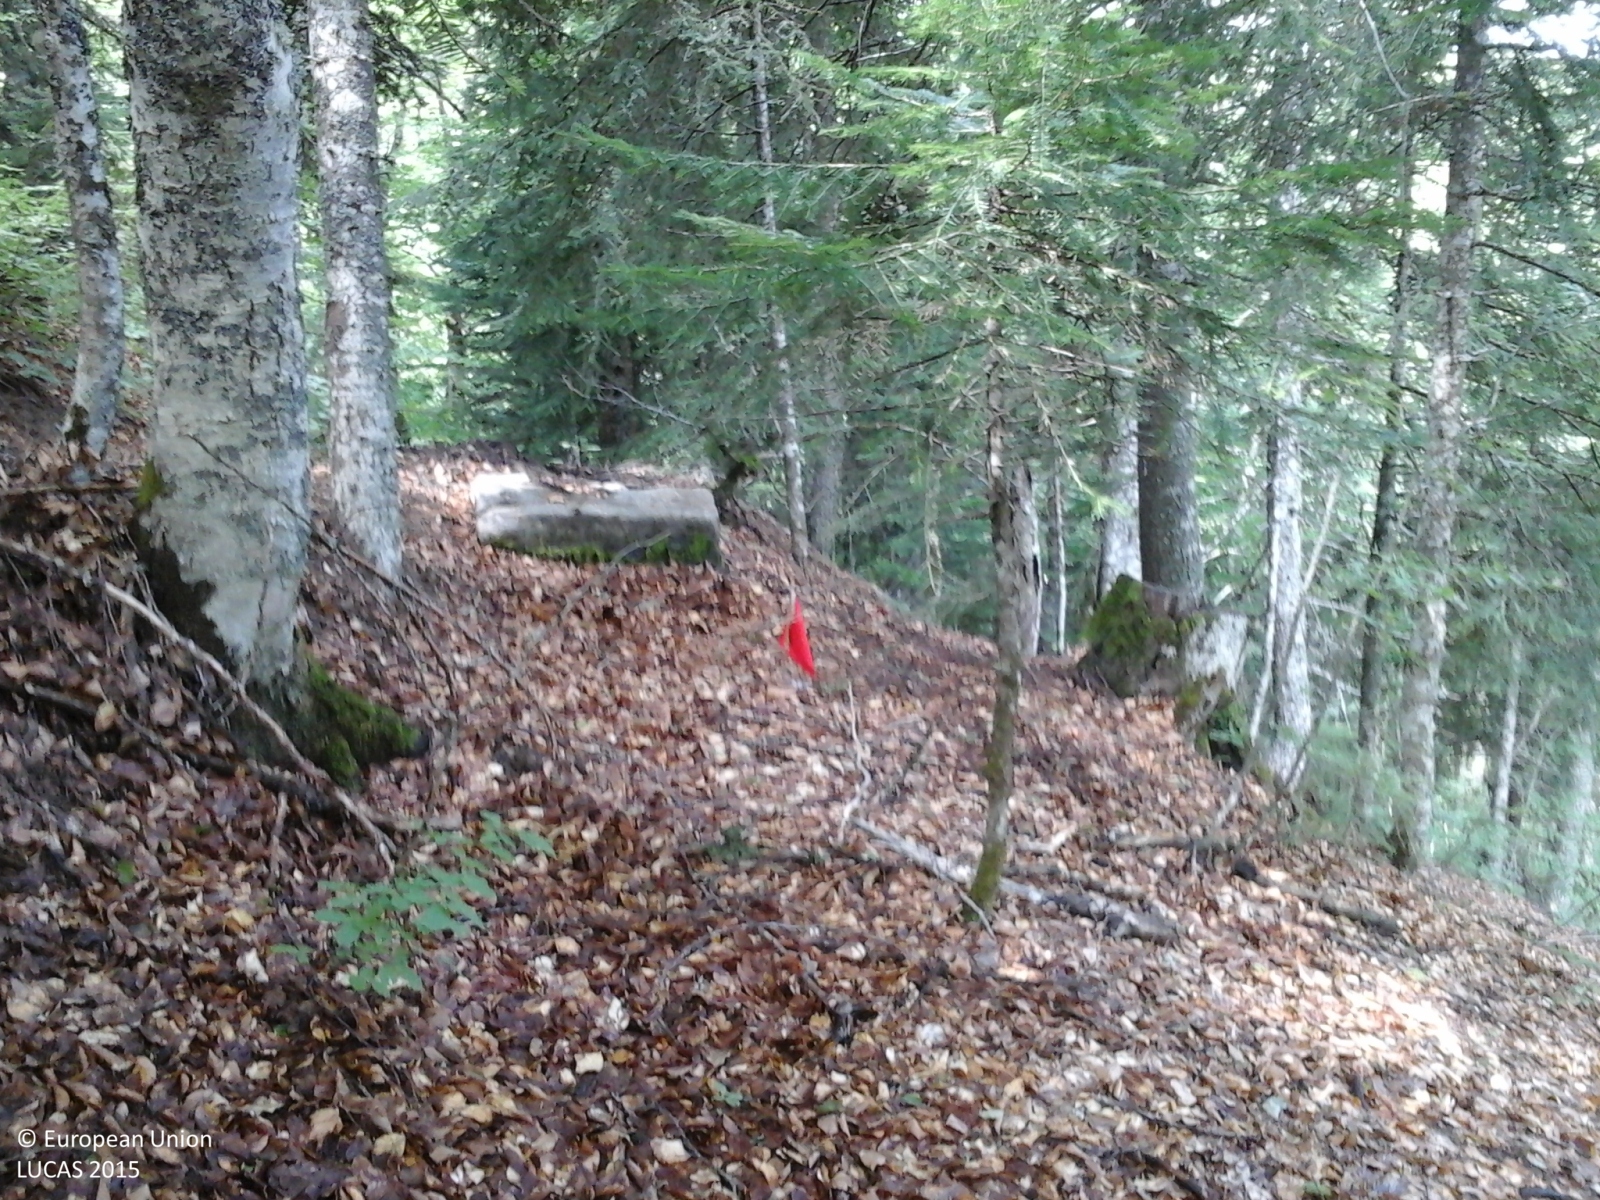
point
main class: Woodland
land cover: Spruce dominated coniferous woodland
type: coniferous forest of the mediterranean region
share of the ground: 50 - 75 %
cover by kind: coniferous forest trees 70 %, unconsolidated bare surface 20 %, herbaceous plants 10 %
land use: Forestry
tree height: > 5 m
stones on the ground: 10 - 25 %
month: August
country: GR
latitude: 40.3356
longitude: 21.0396
